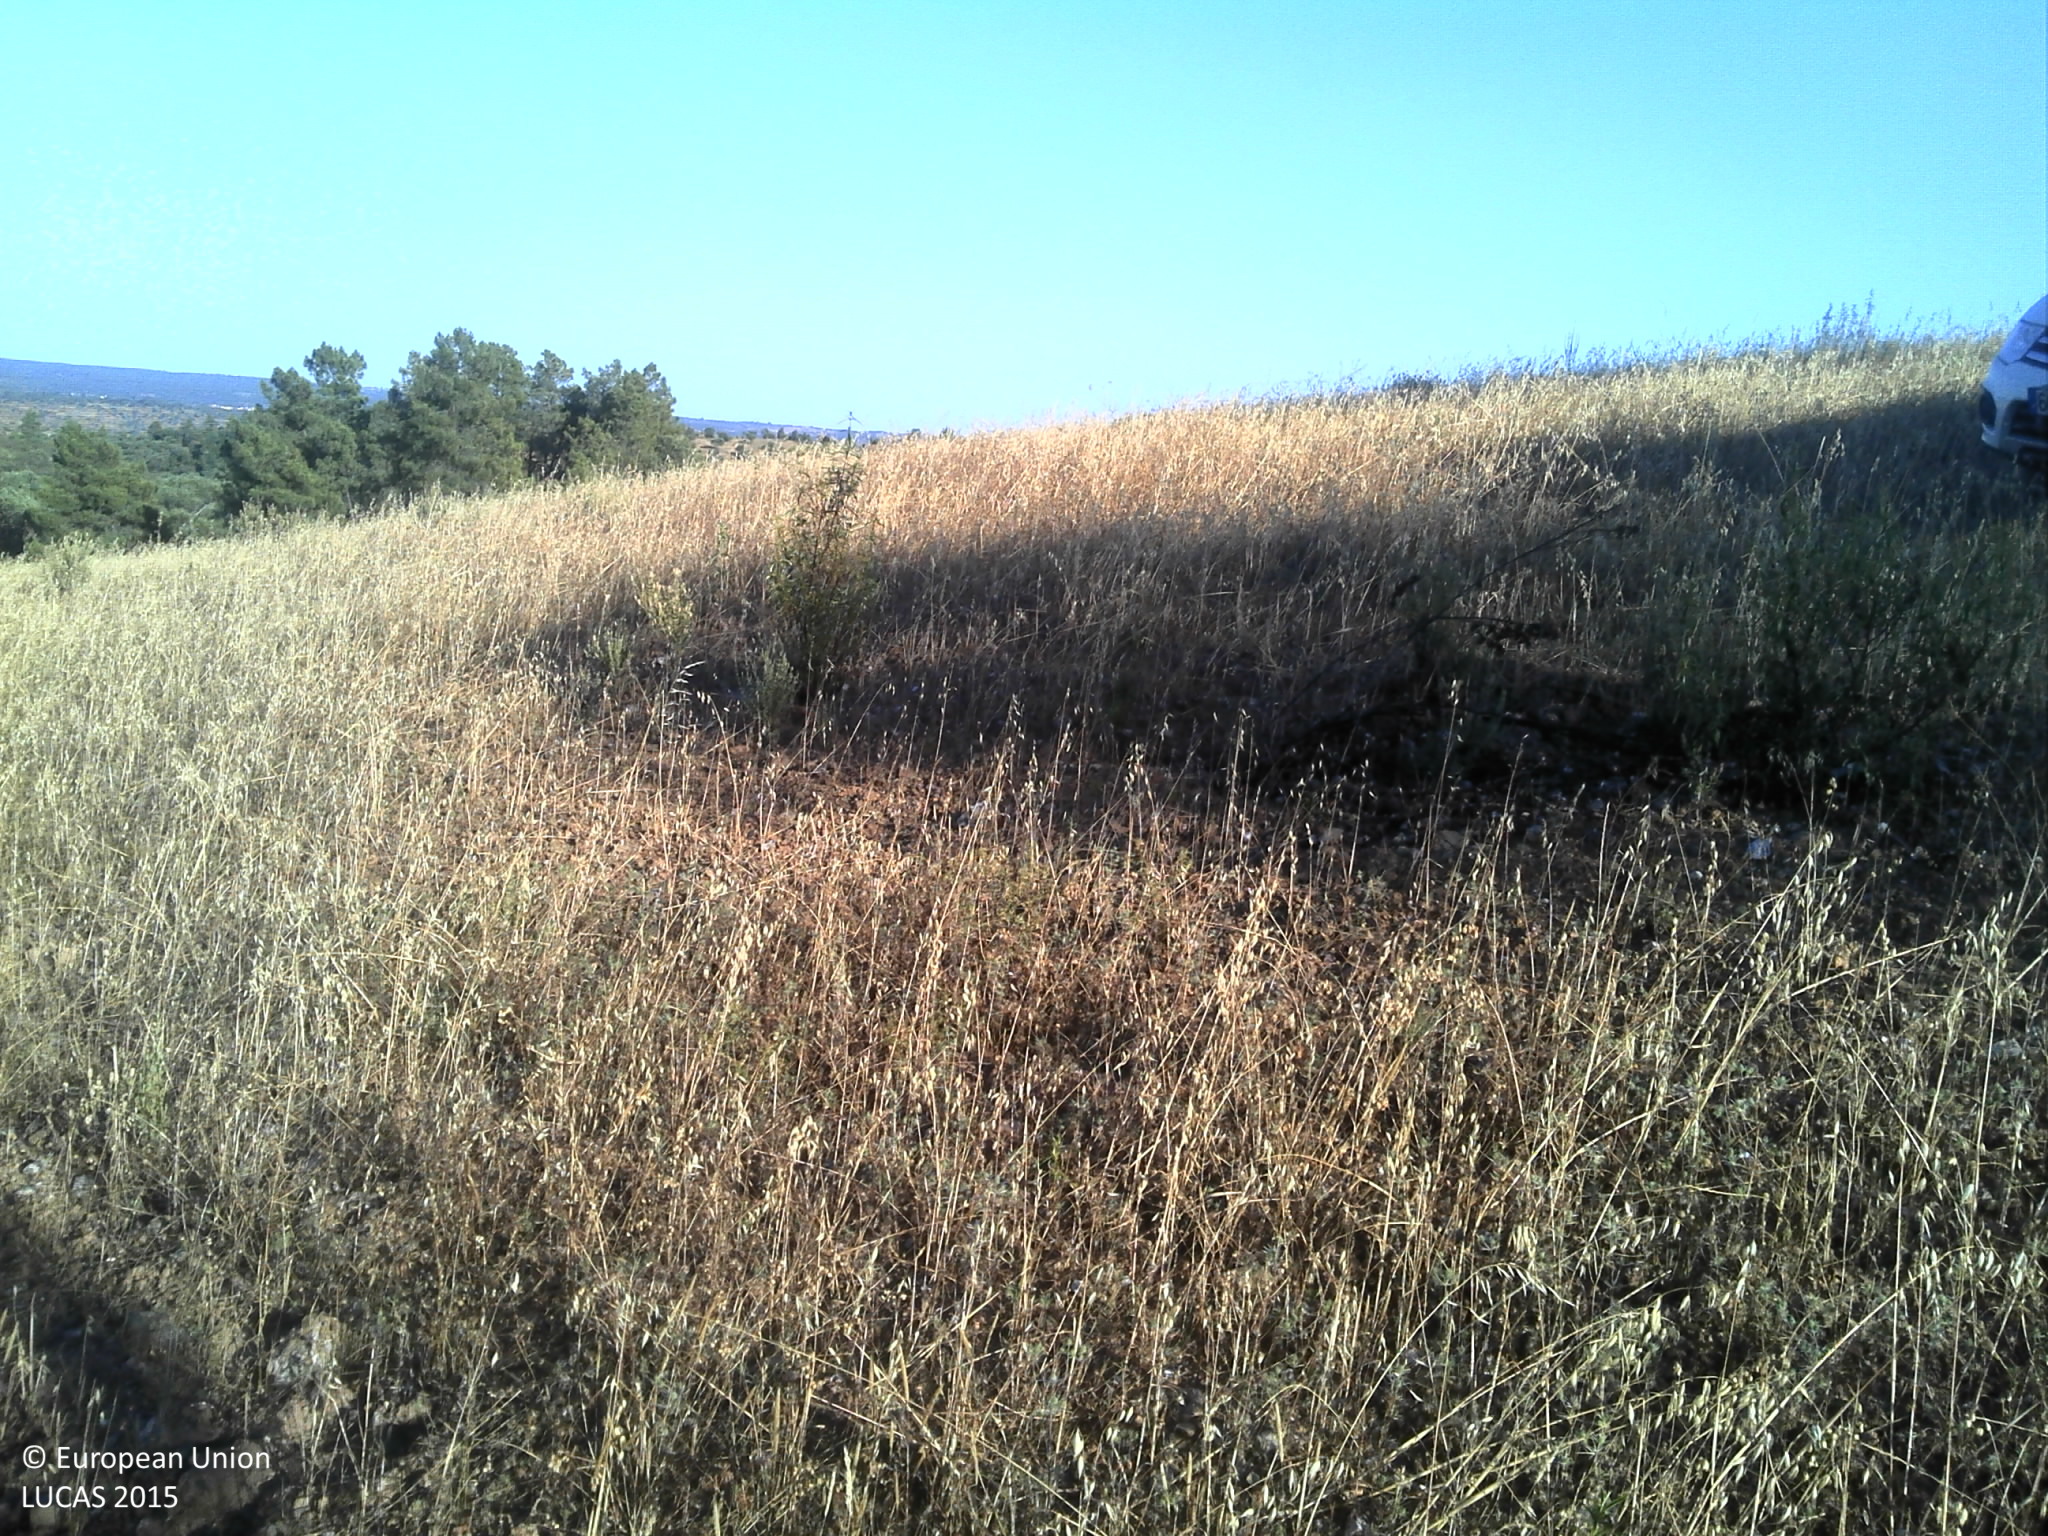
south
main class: Shrubland
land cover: Shrubland with sparse tree cover
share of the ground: 50 - 75 %
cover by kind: shrubs 75 %, herbaceous plants 10 %, coniferous forest trees 5 %, unconsolidated bare surface 5 %
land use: Forestry
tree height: > 5 m
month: June
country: PT
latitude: 39.9524
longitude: -7.0995
